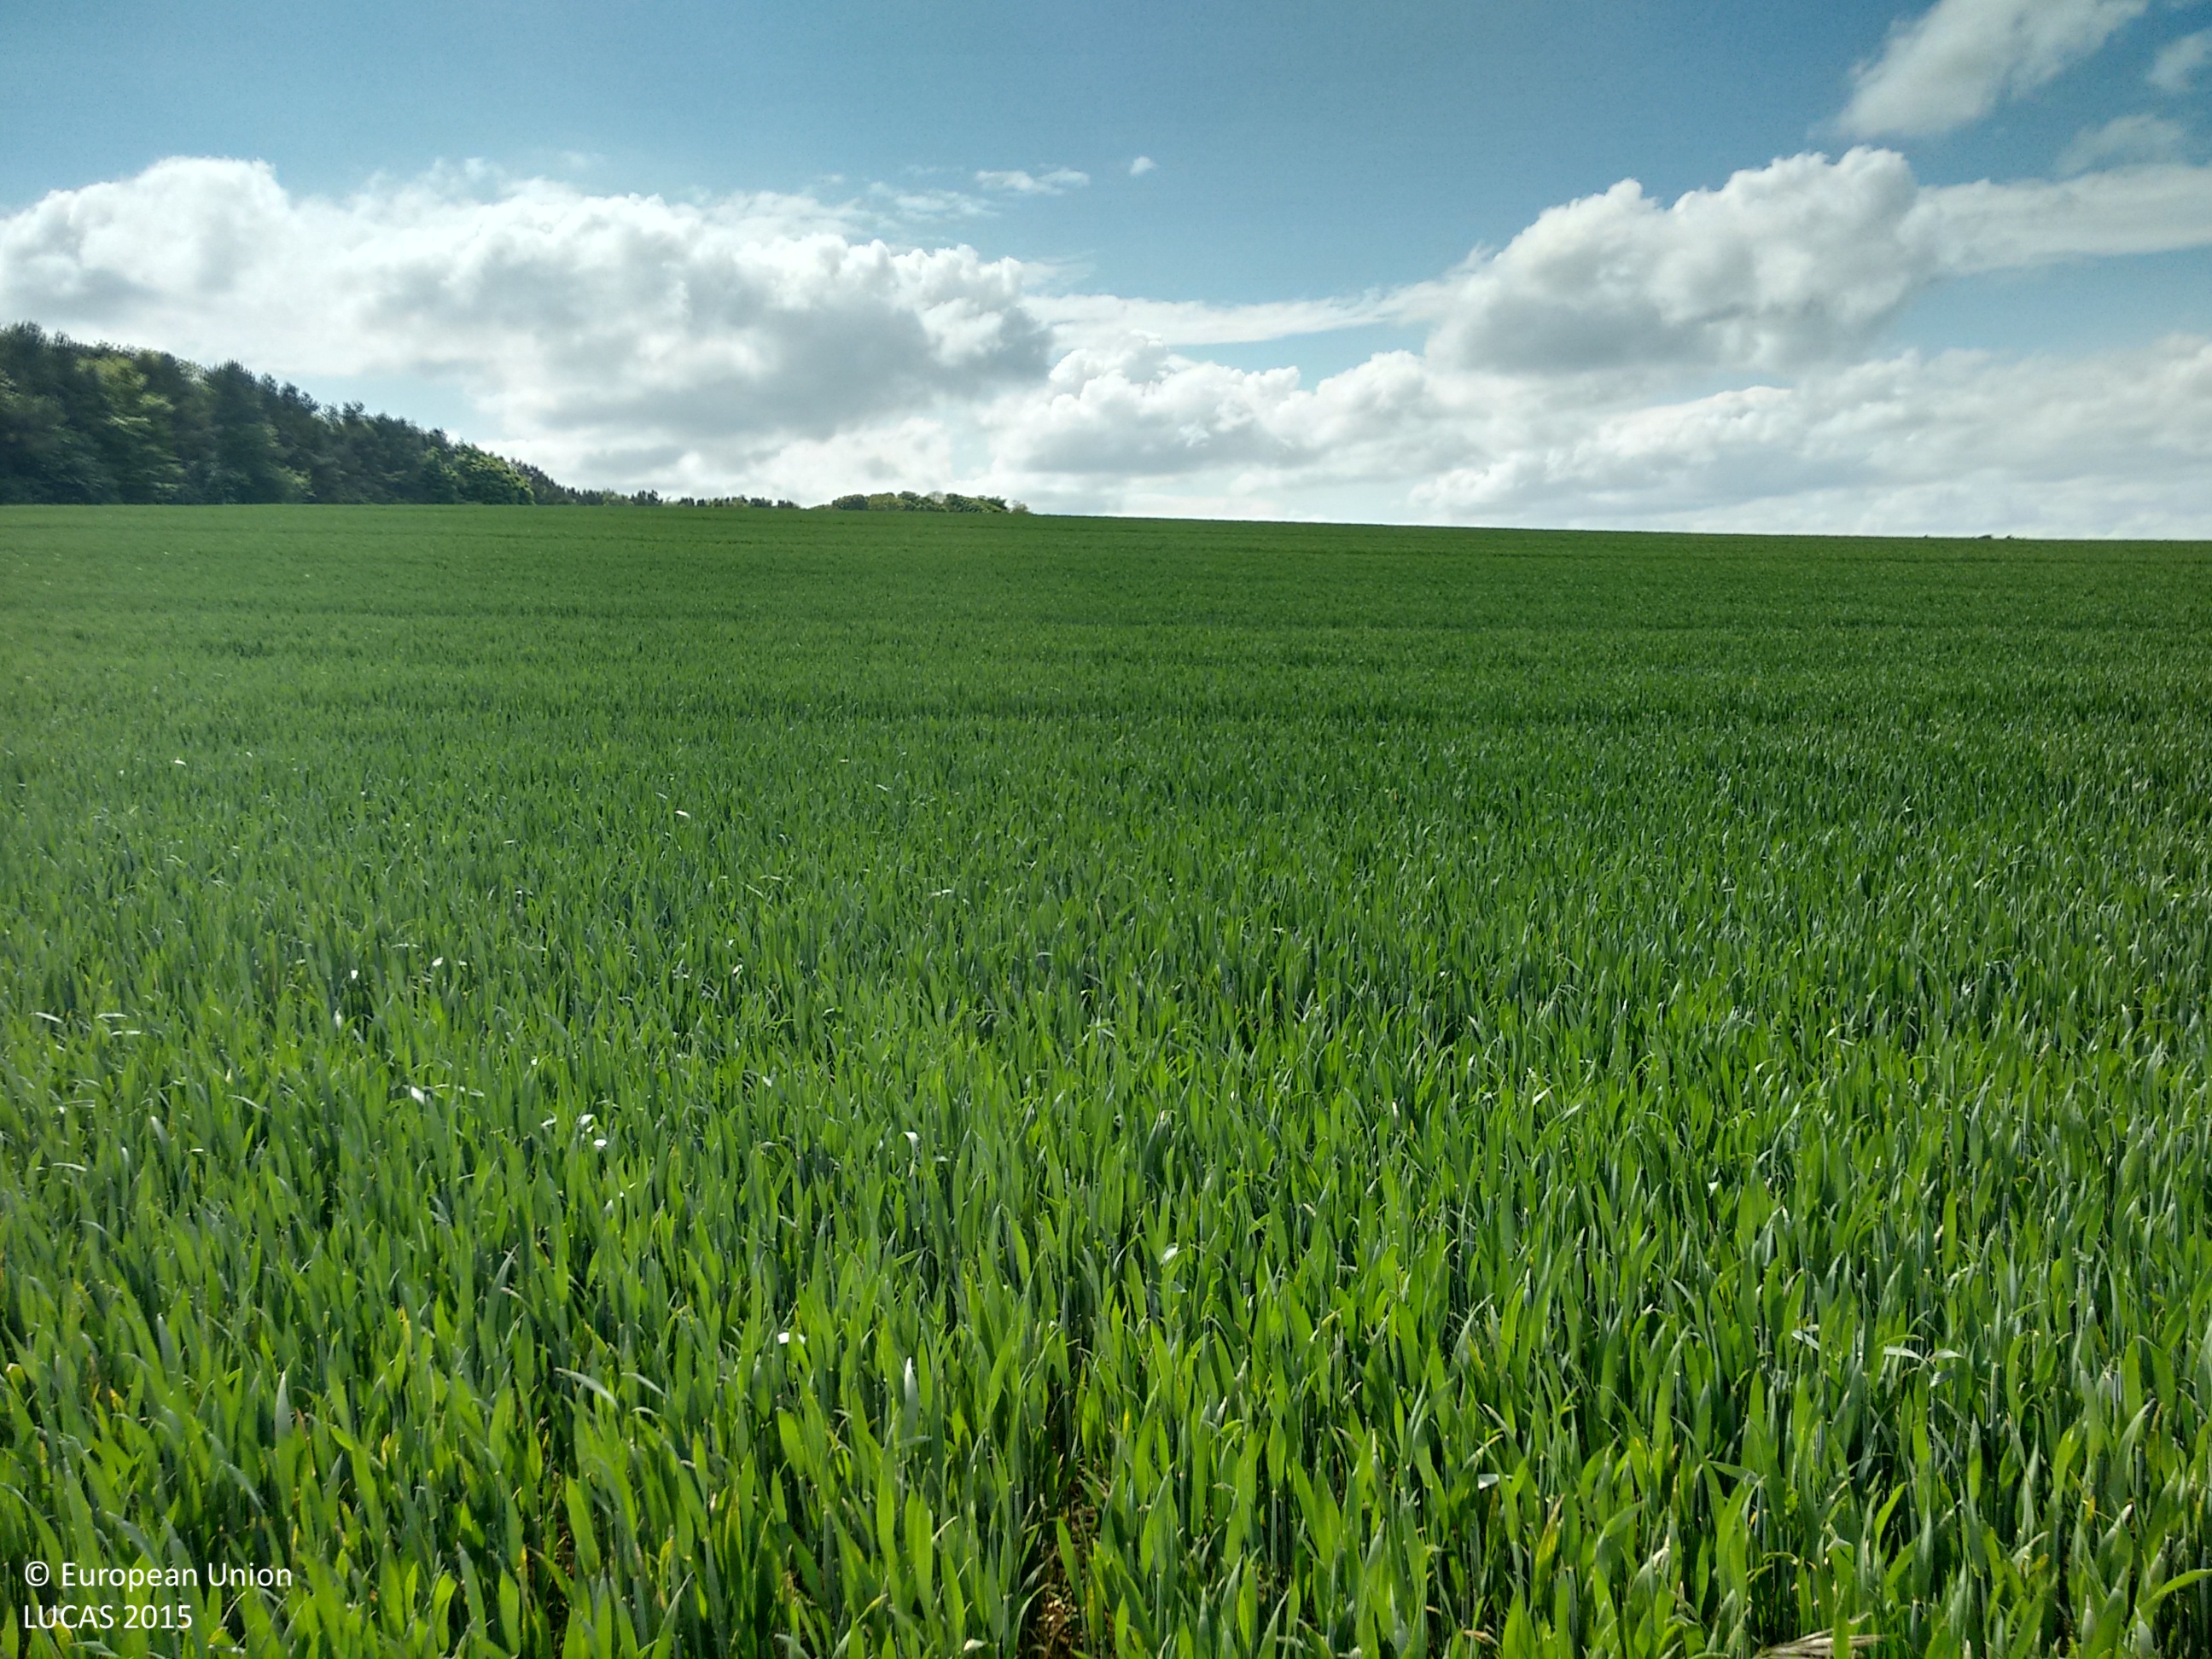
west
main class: Cropland
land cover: Common wheat
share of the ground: > 75 %
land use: Agriculture (excluding fallow land and kitchen gardens)
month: June
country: GB
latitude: 55.4383
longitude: -1.6336
